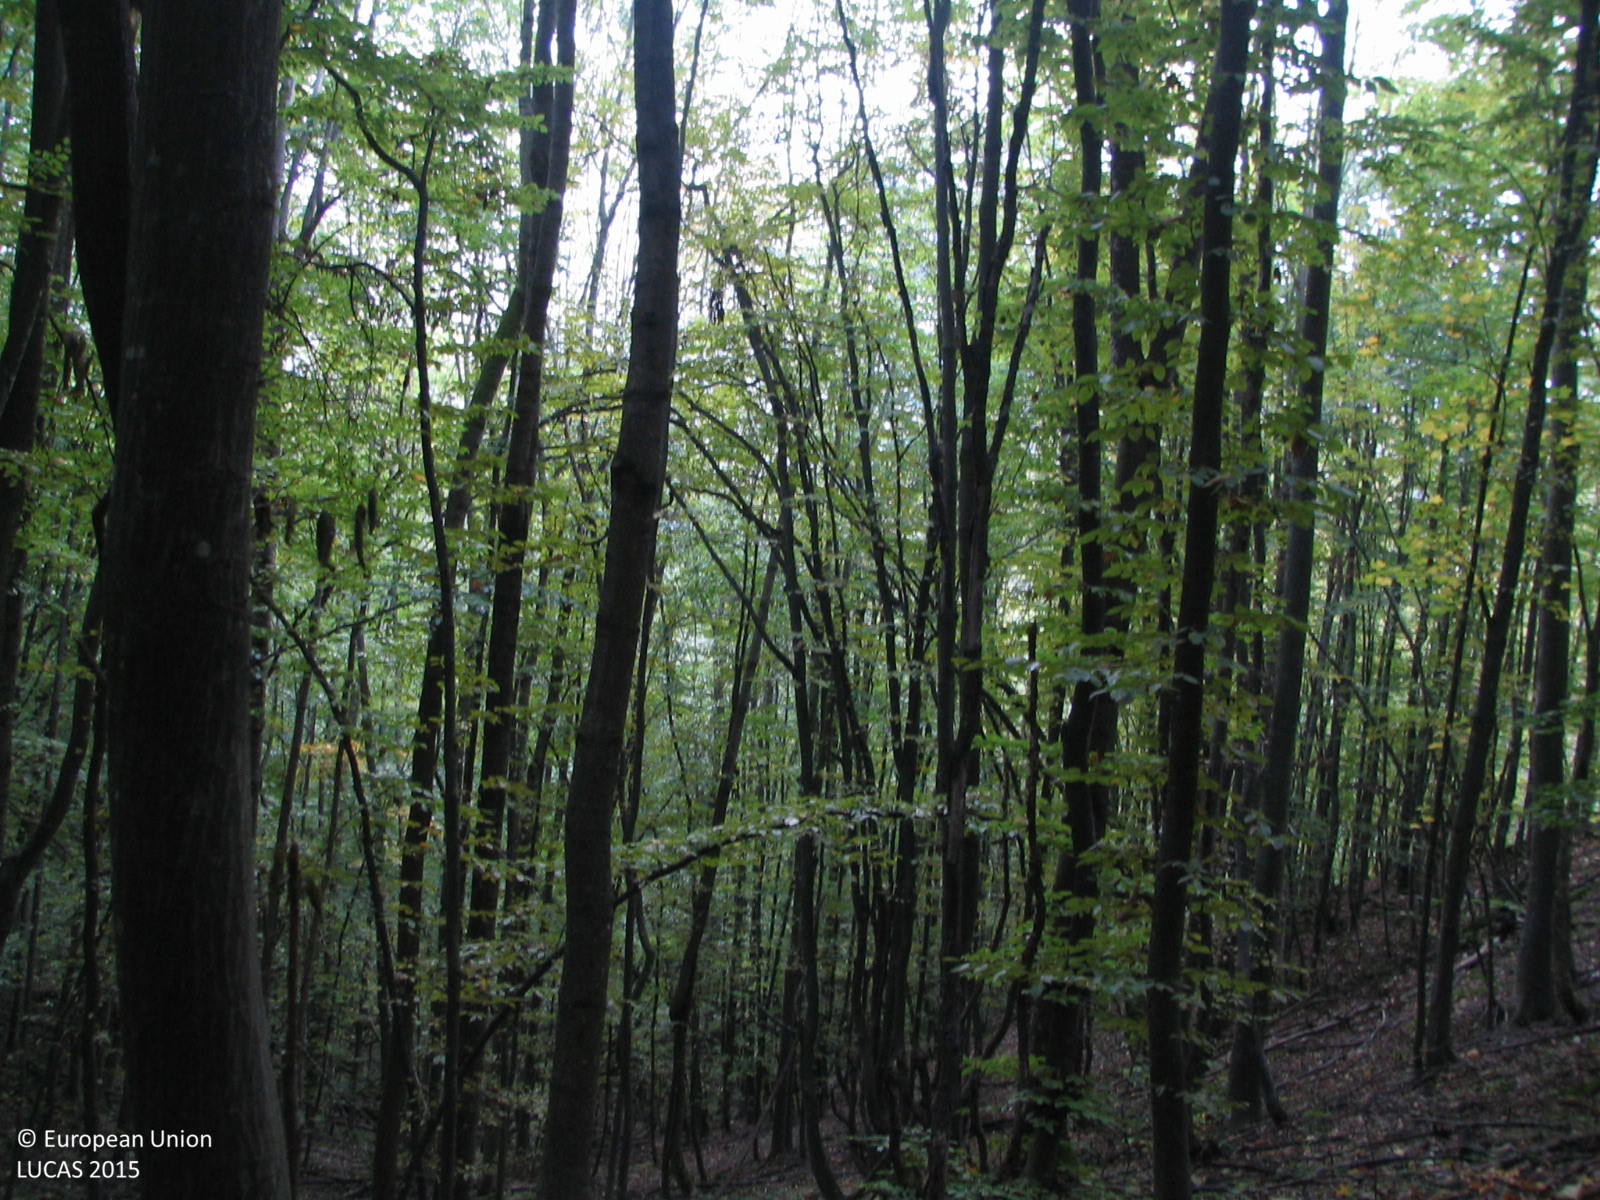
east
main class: Woodland
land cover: Broadleaved woodland
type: beech forest
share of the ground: > 75 %
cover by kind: broadleaved forest trees 100 %
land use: Forestry
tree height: > 5 m
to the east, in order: Broadleaved woodland
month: October
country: BG
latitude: 42.8539
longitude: 24.0845
